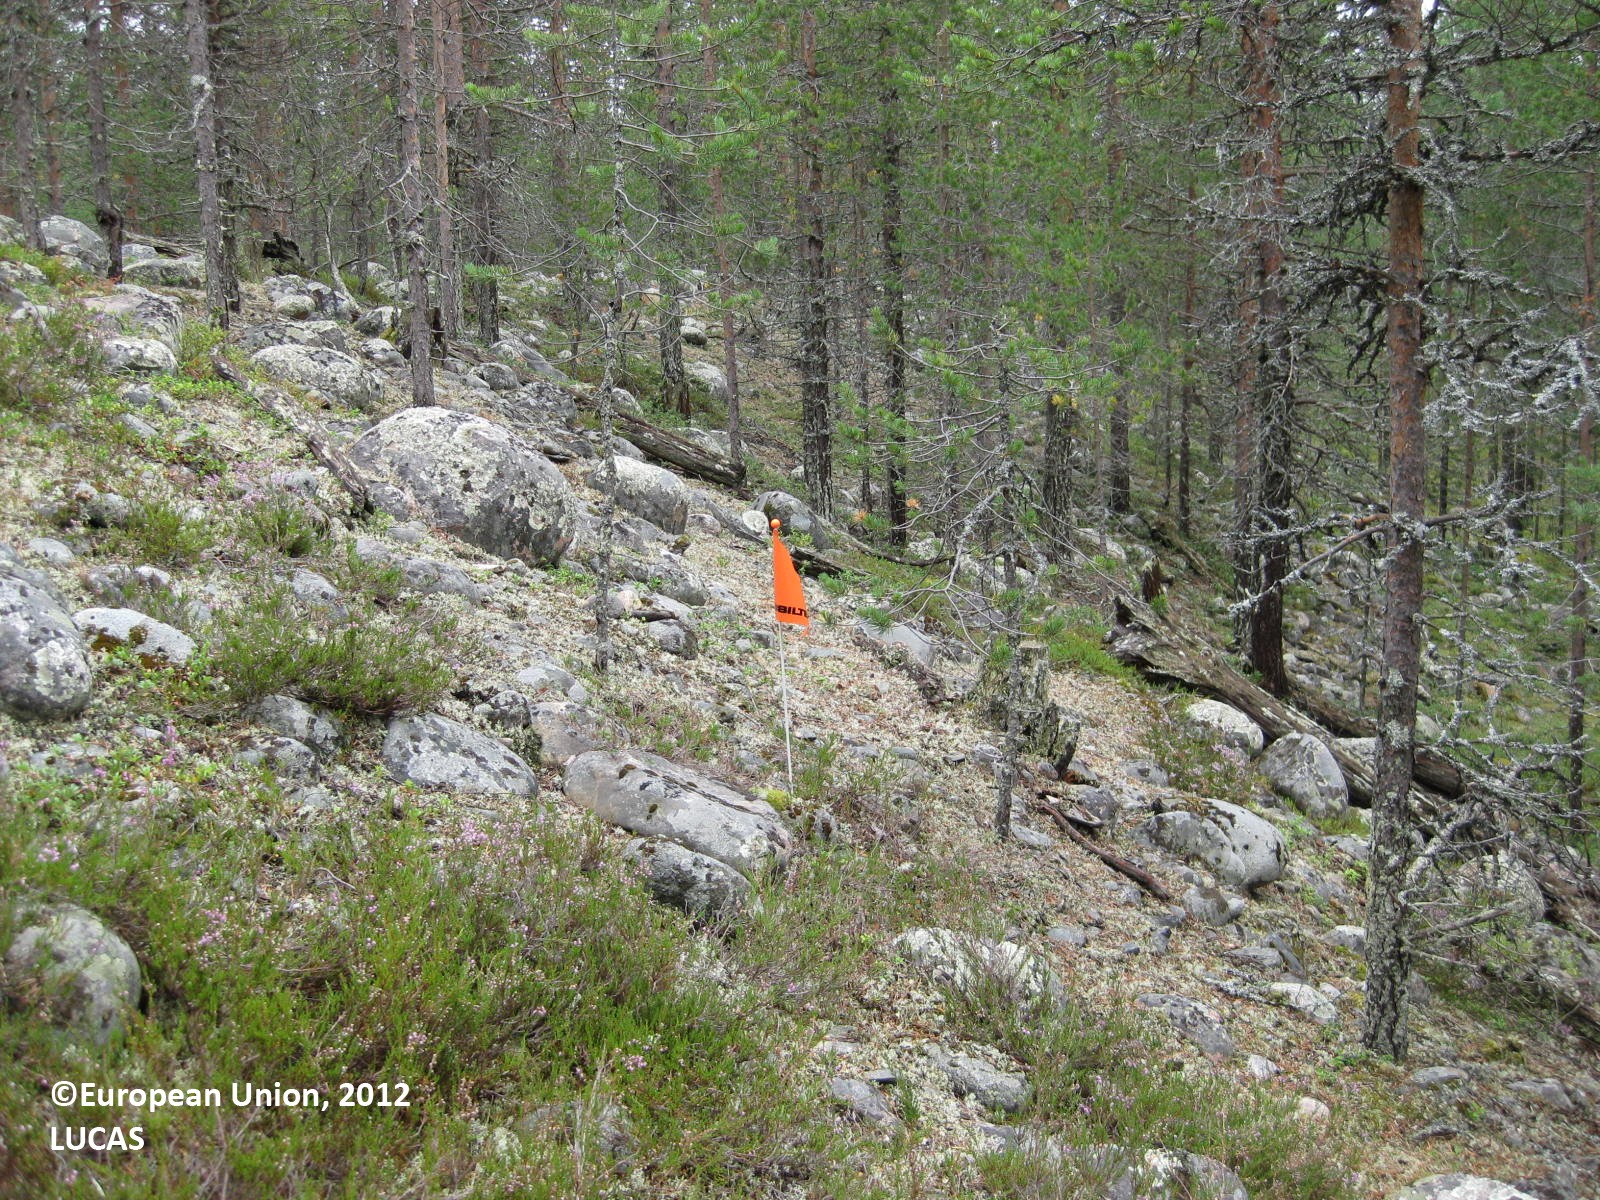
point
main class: Woodland
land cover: Pine dominated coniferous woodland
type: boreal forest
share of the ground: 50 - 75 %
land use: Forestry
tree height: > 5 m
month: August
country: FI
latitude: 66.0073
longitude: 28.1483
